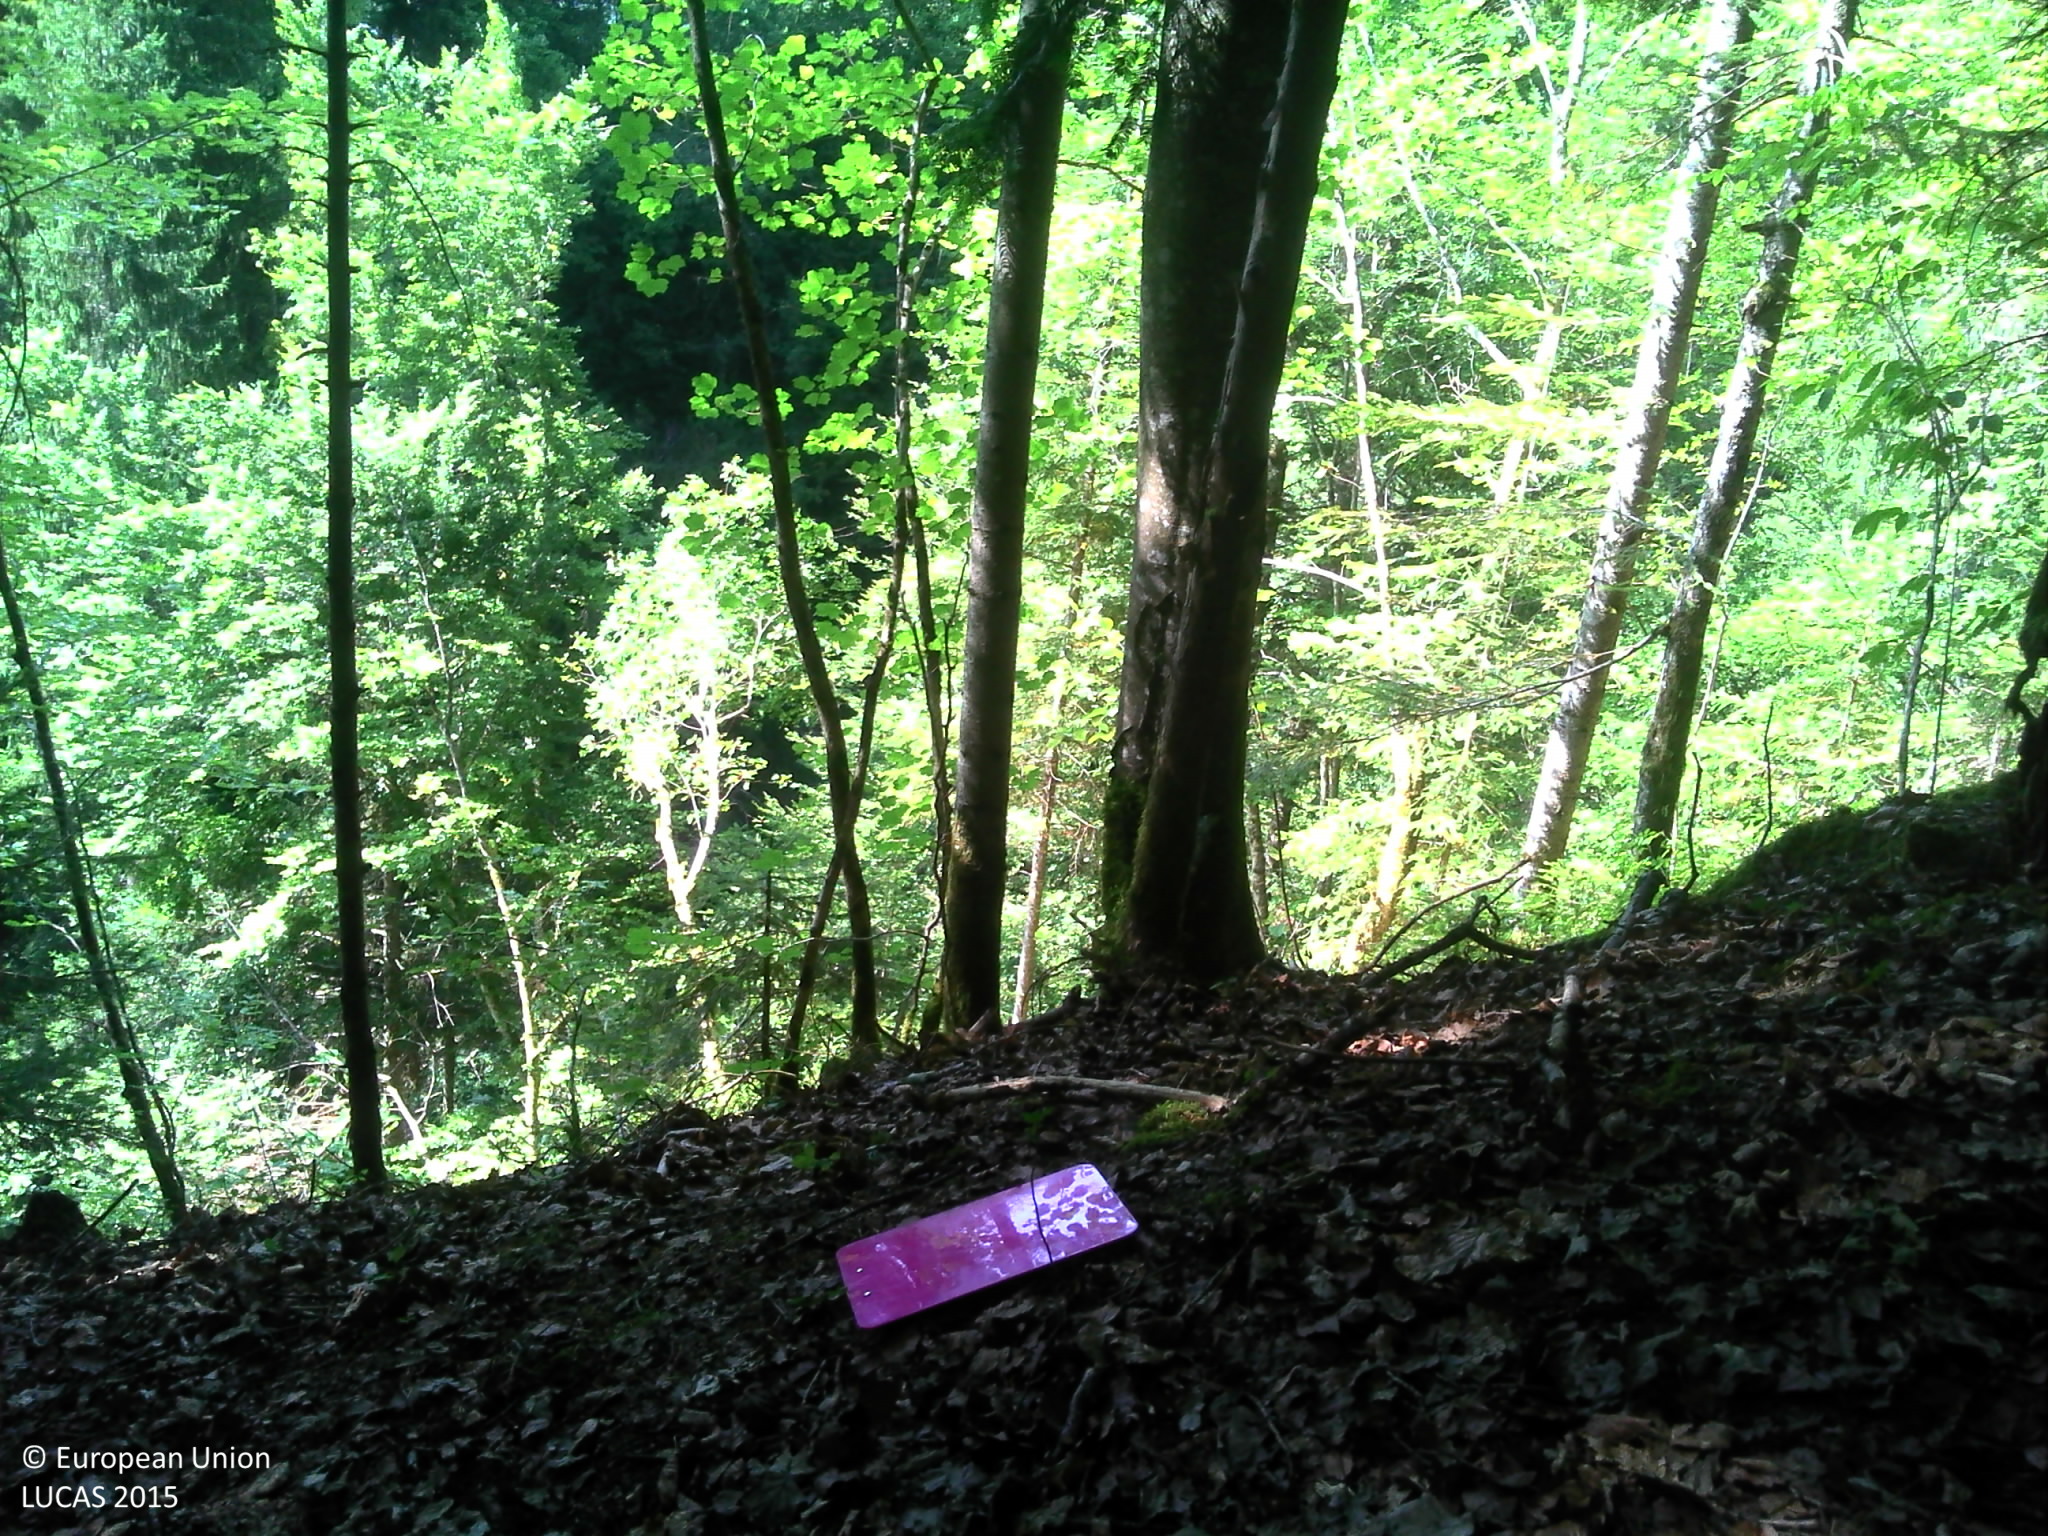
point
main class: Woodland
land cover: Spruce dominated mixed woodland
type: mountainous beech forest
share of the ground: > 75 %
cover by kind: broadleaved forest trees 40 %, coniferous forest trees 35 %, herbaceous plants 20 %, lichens and mosses 5 %
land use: Forestry
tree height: > 5 m
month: July
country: FR
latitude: 45.7288
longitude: 6.3164
